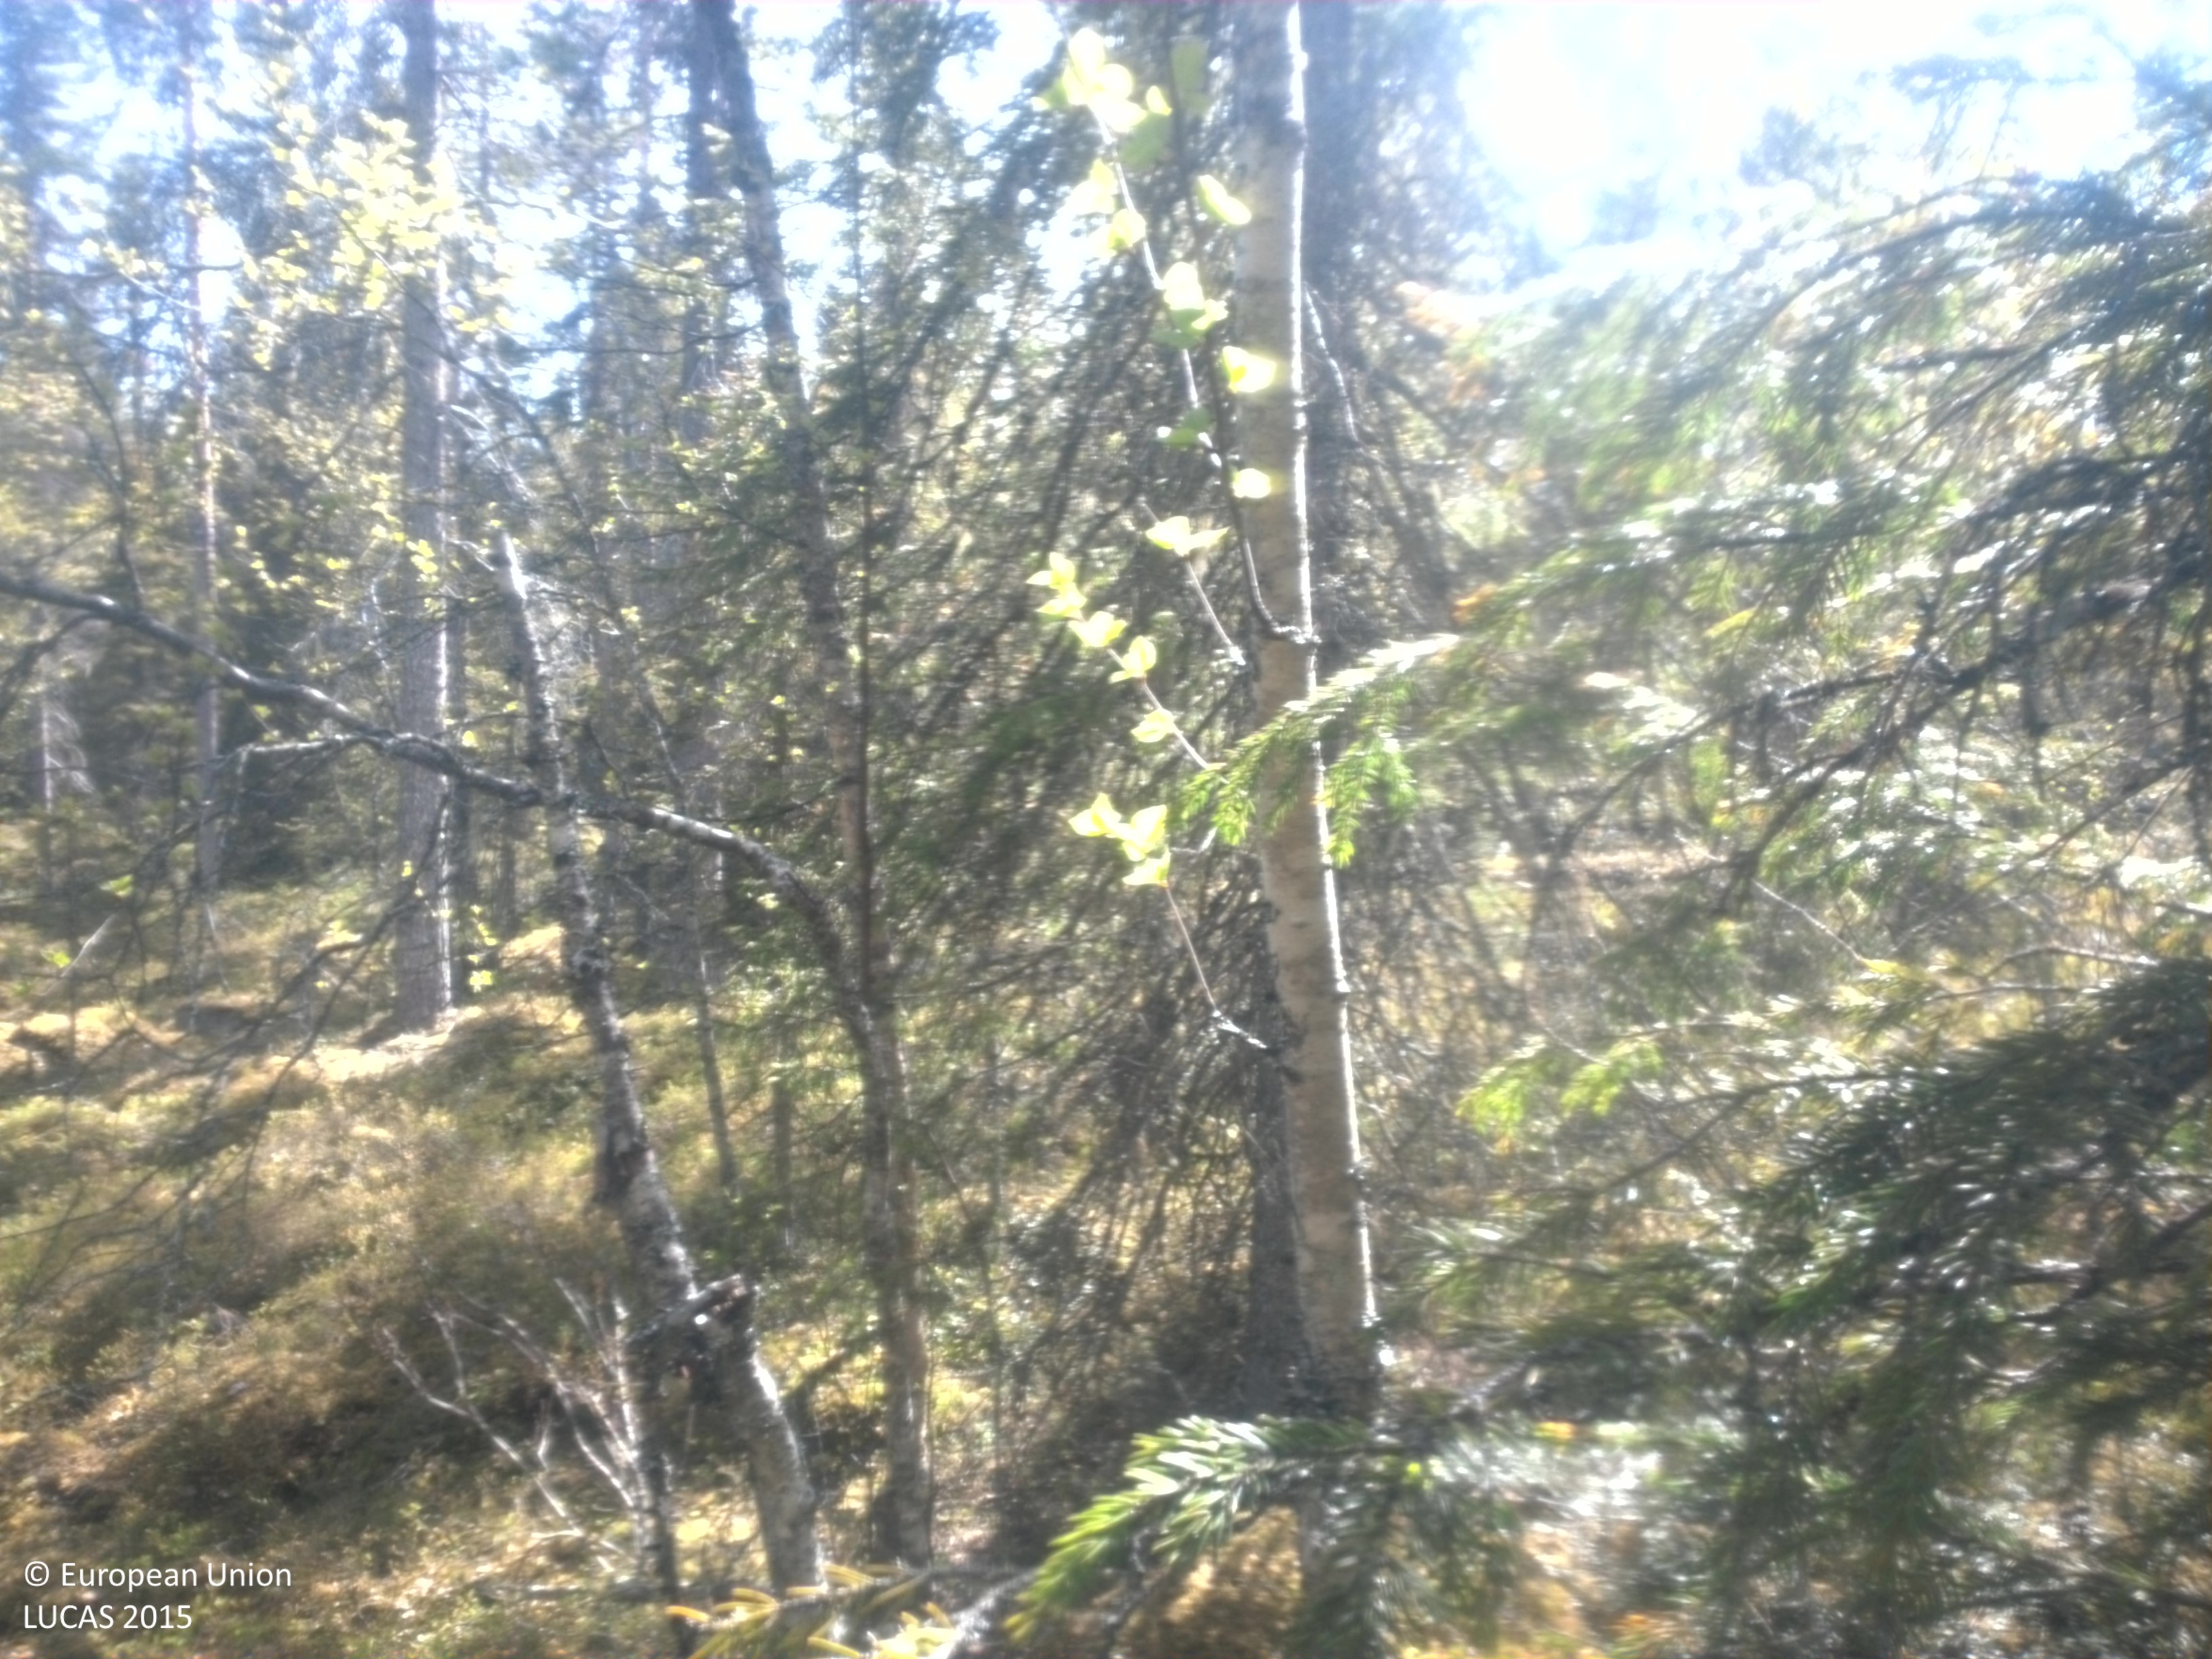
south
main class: Woodland
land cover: Pine dominated coniferous woodland
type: boreal forest
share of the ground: 50 - 75 %
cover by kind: coniferous forest trees 50 %, herbaceous plants 25 %, lichens and mosses 10 %, broadleaved forest trees 5 %, shrubs 5 %, unconsolidated bare surface 5 %
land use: Forestry
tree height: > 5 m
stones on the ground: 25 - 50 %
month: June
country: SE
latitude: 64.3368
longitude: 17.7292
